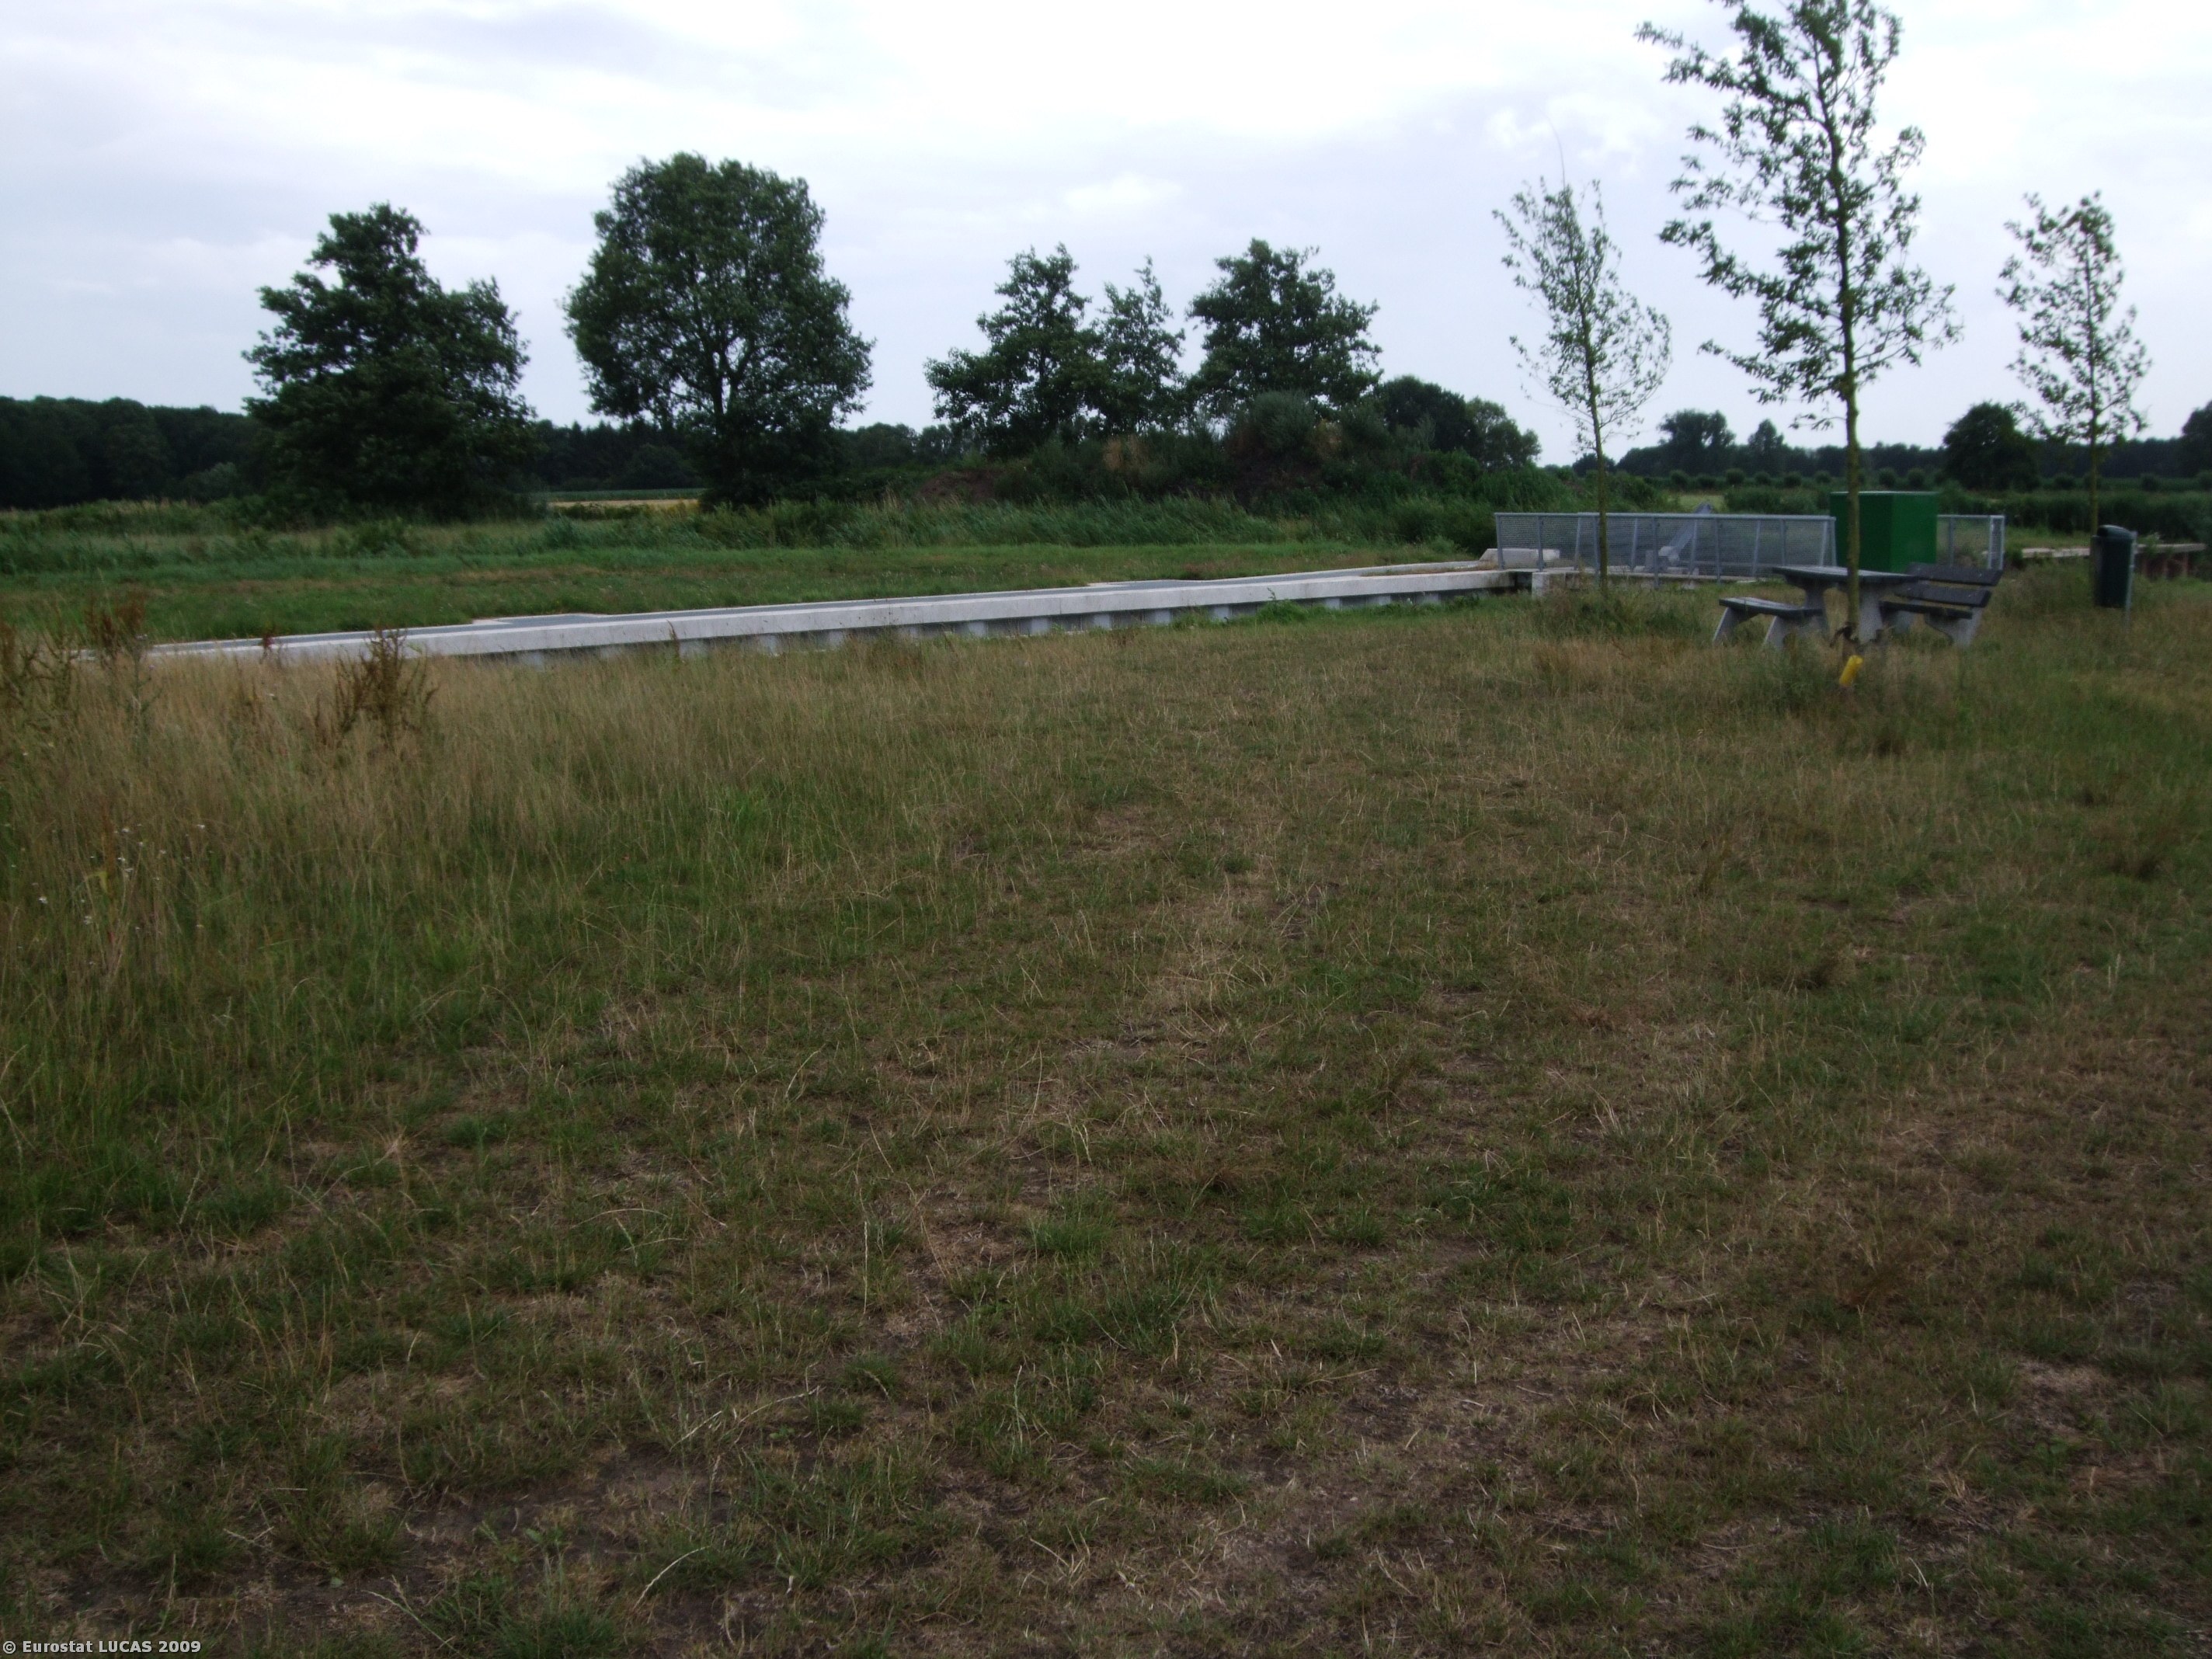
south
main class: Grassland
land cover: Grassland without tree/shrub cover
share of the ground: > 75 %
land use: Agriculture (excluding fallow land and kitchen gardens)
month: July
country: NL
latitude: 51.3371
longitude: 5.4765
